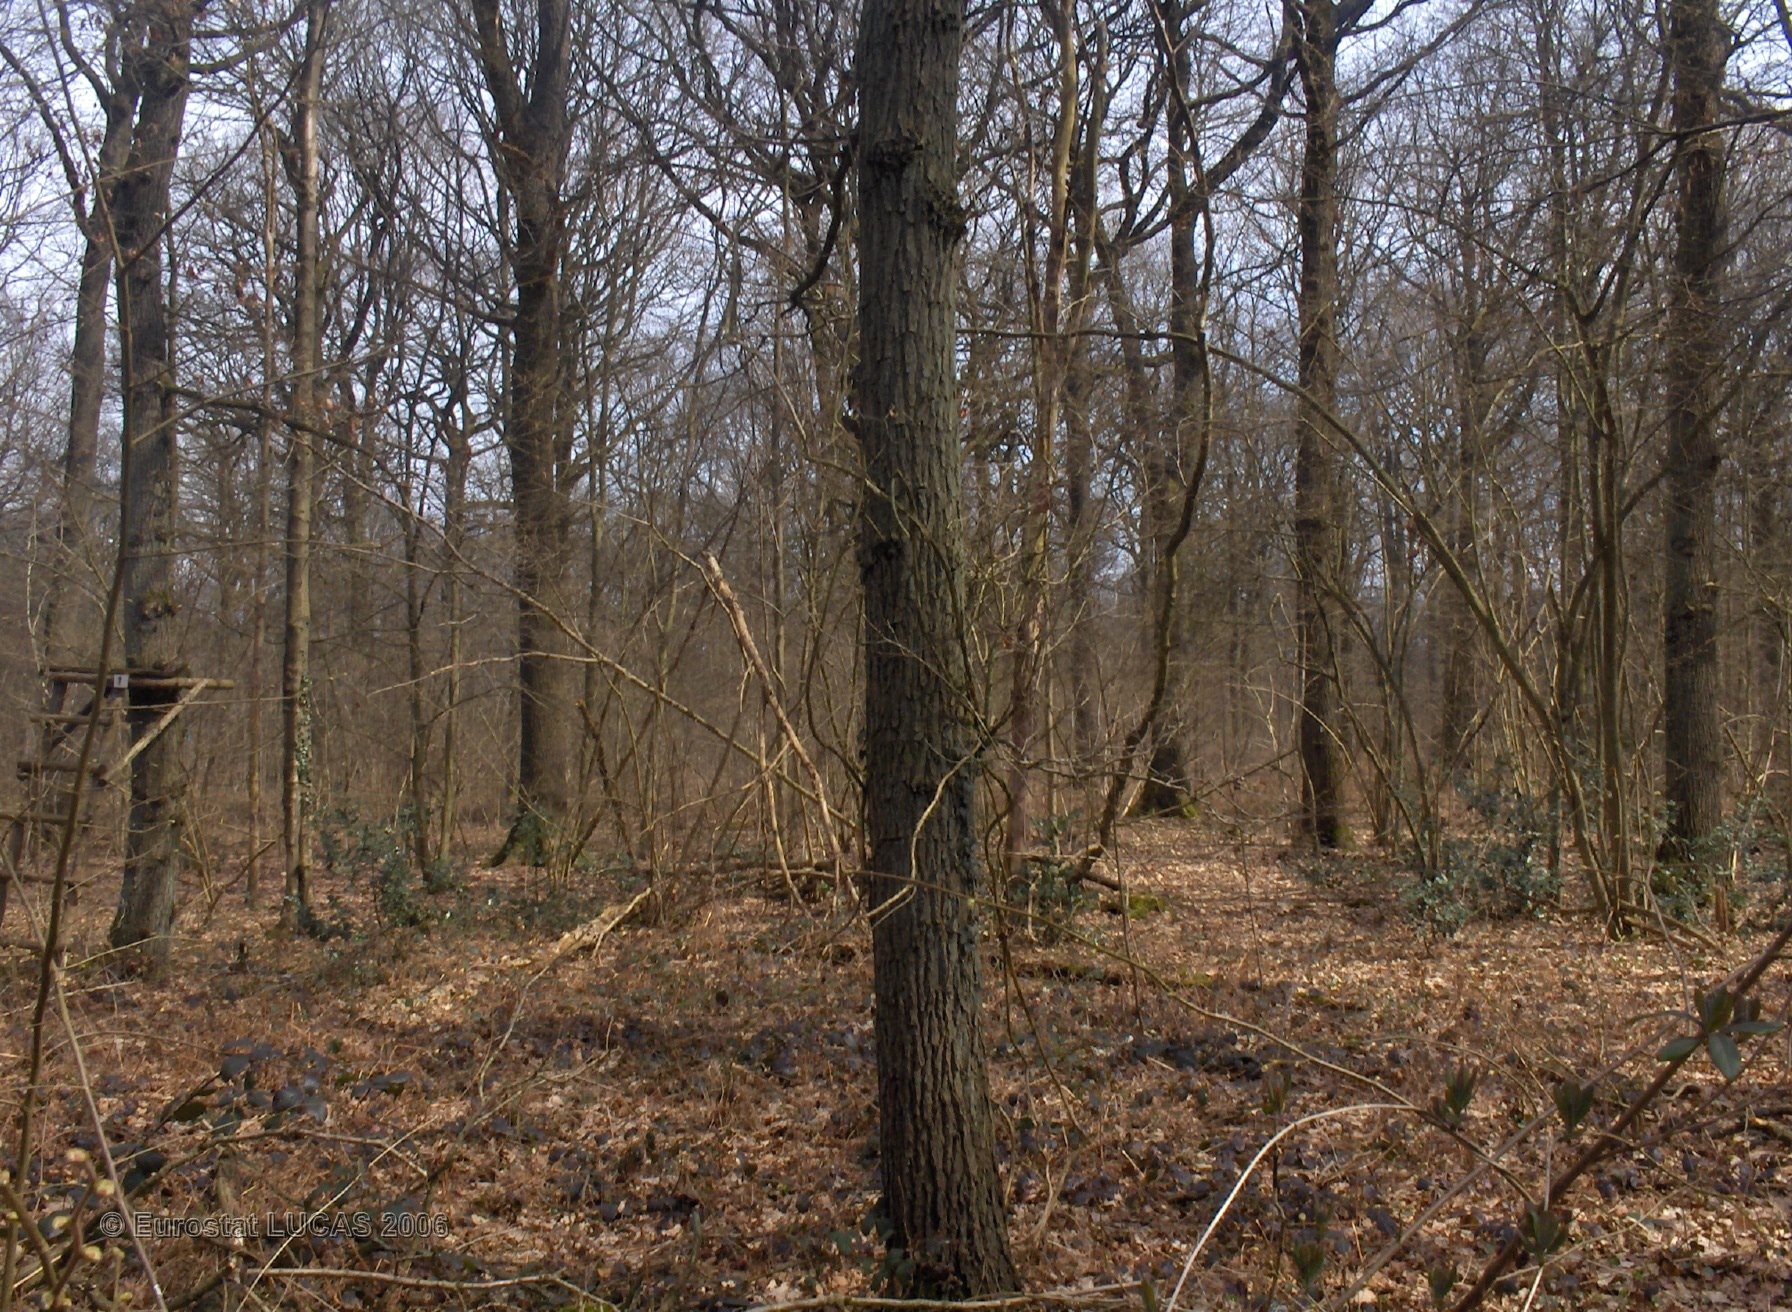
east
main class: Woodland
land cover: Mixed forest
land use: Forestry
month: April
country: BE
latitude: 50.3785
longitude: 4.5540
